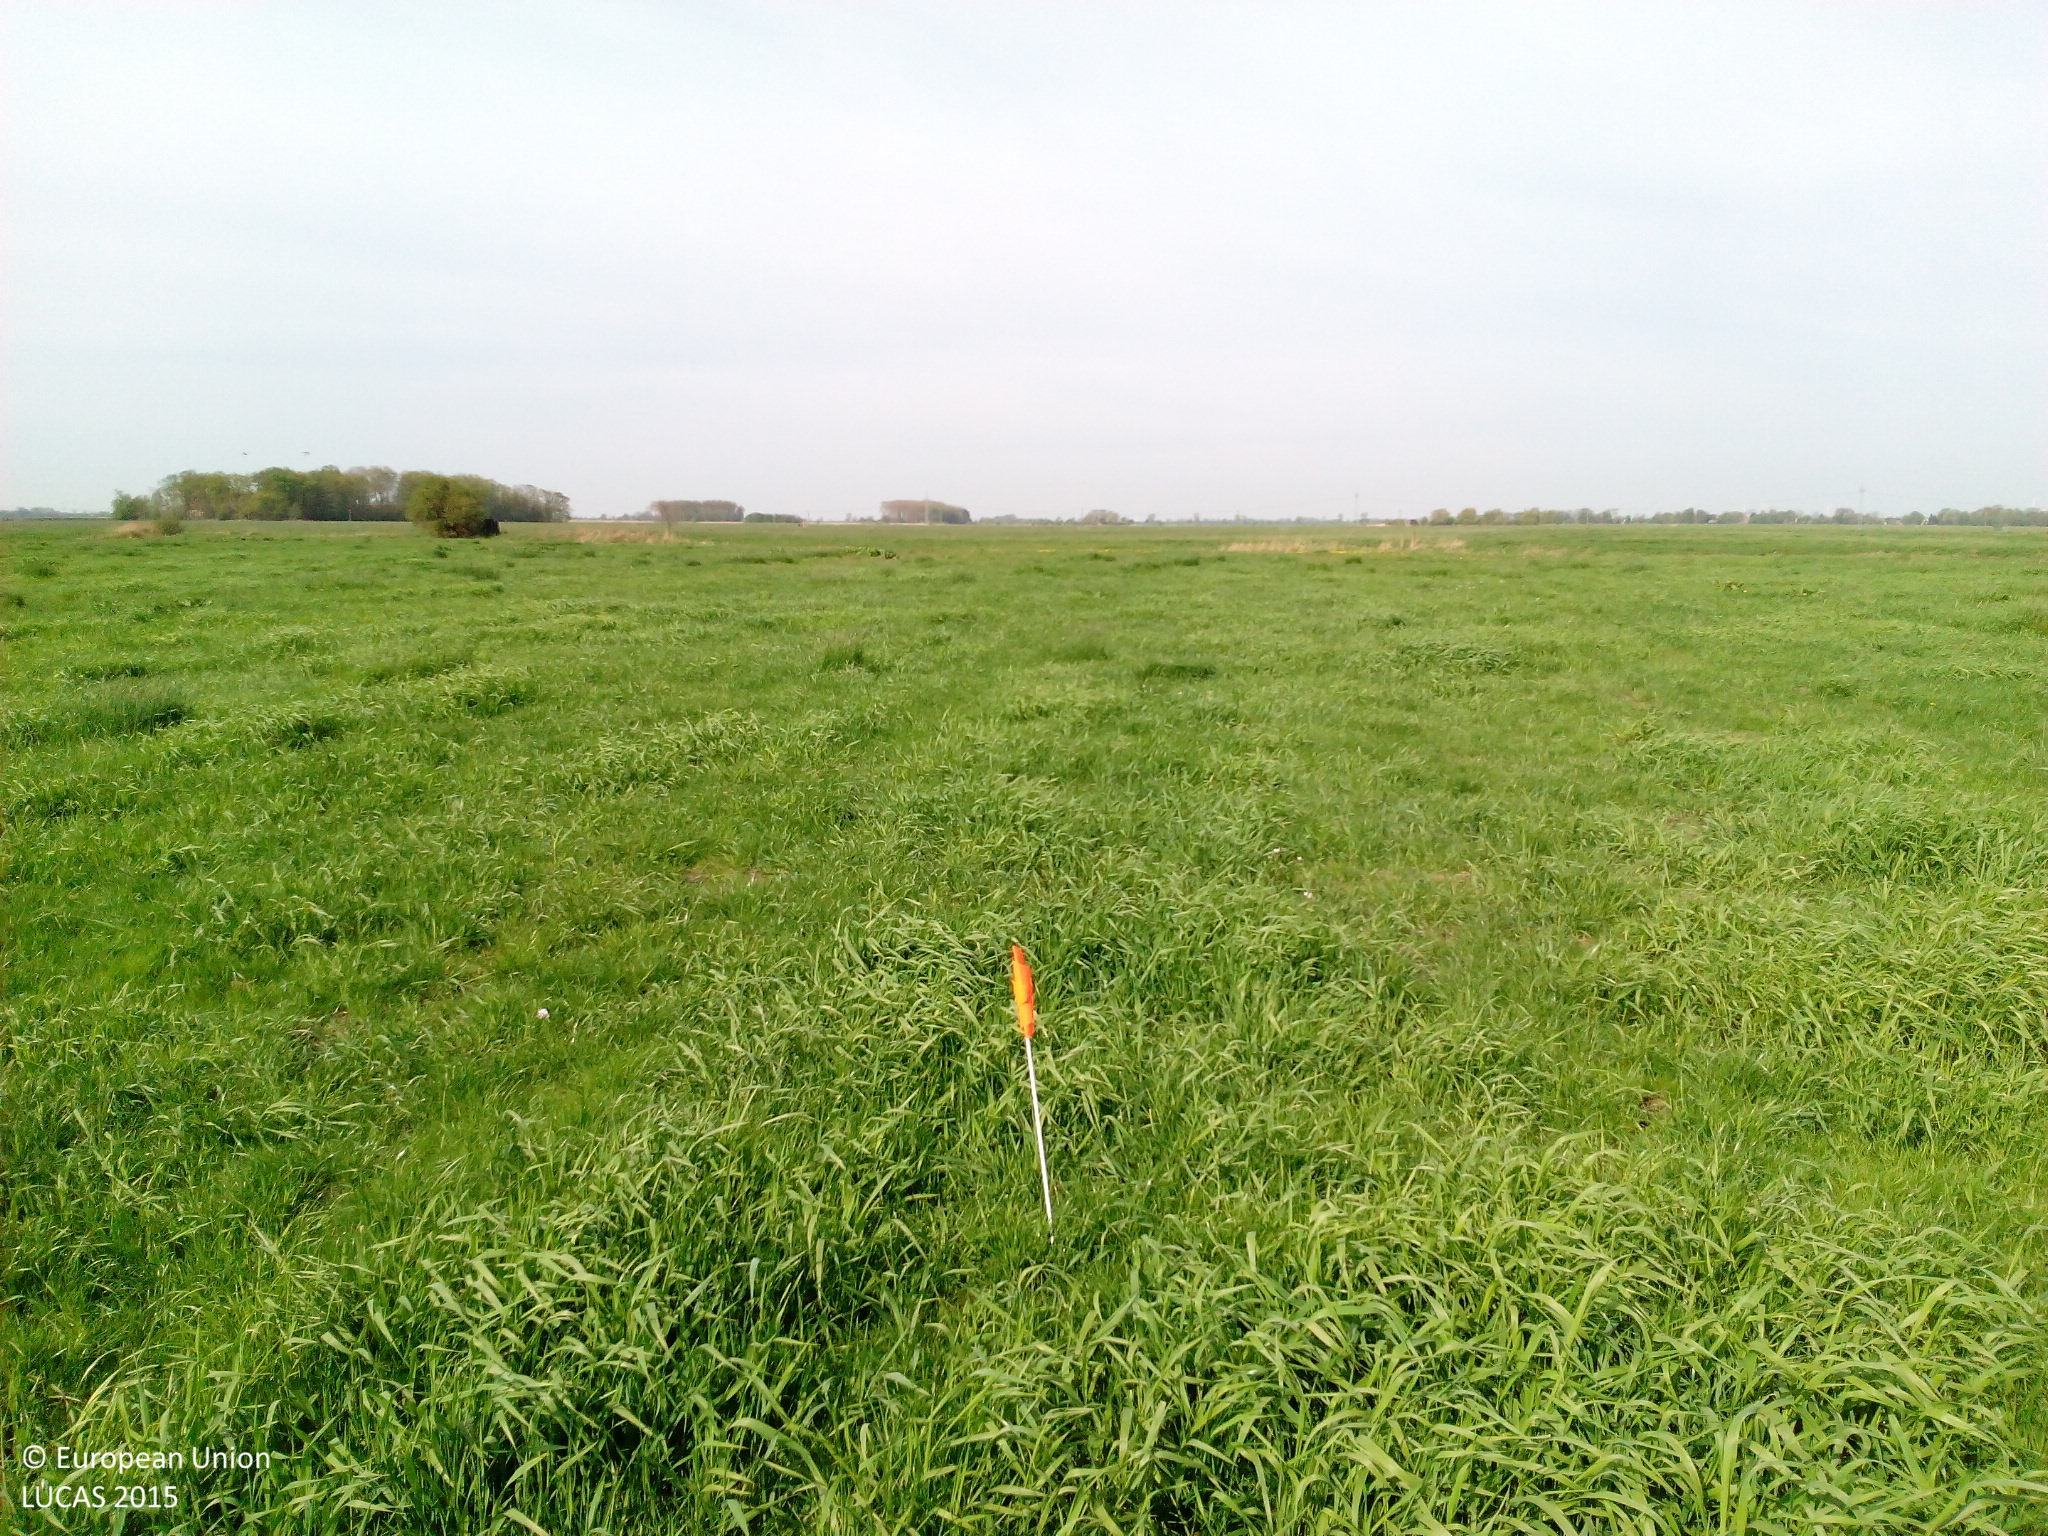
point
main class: Grassland
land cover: Grassland without tree/shrub cover
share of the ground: > 75 %
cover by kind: herbaceous plants 100 %
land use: Agriculture (excluding fallow land and kitchen gardens)
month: May
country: DE
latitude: 53.4115
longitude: 8.5714
